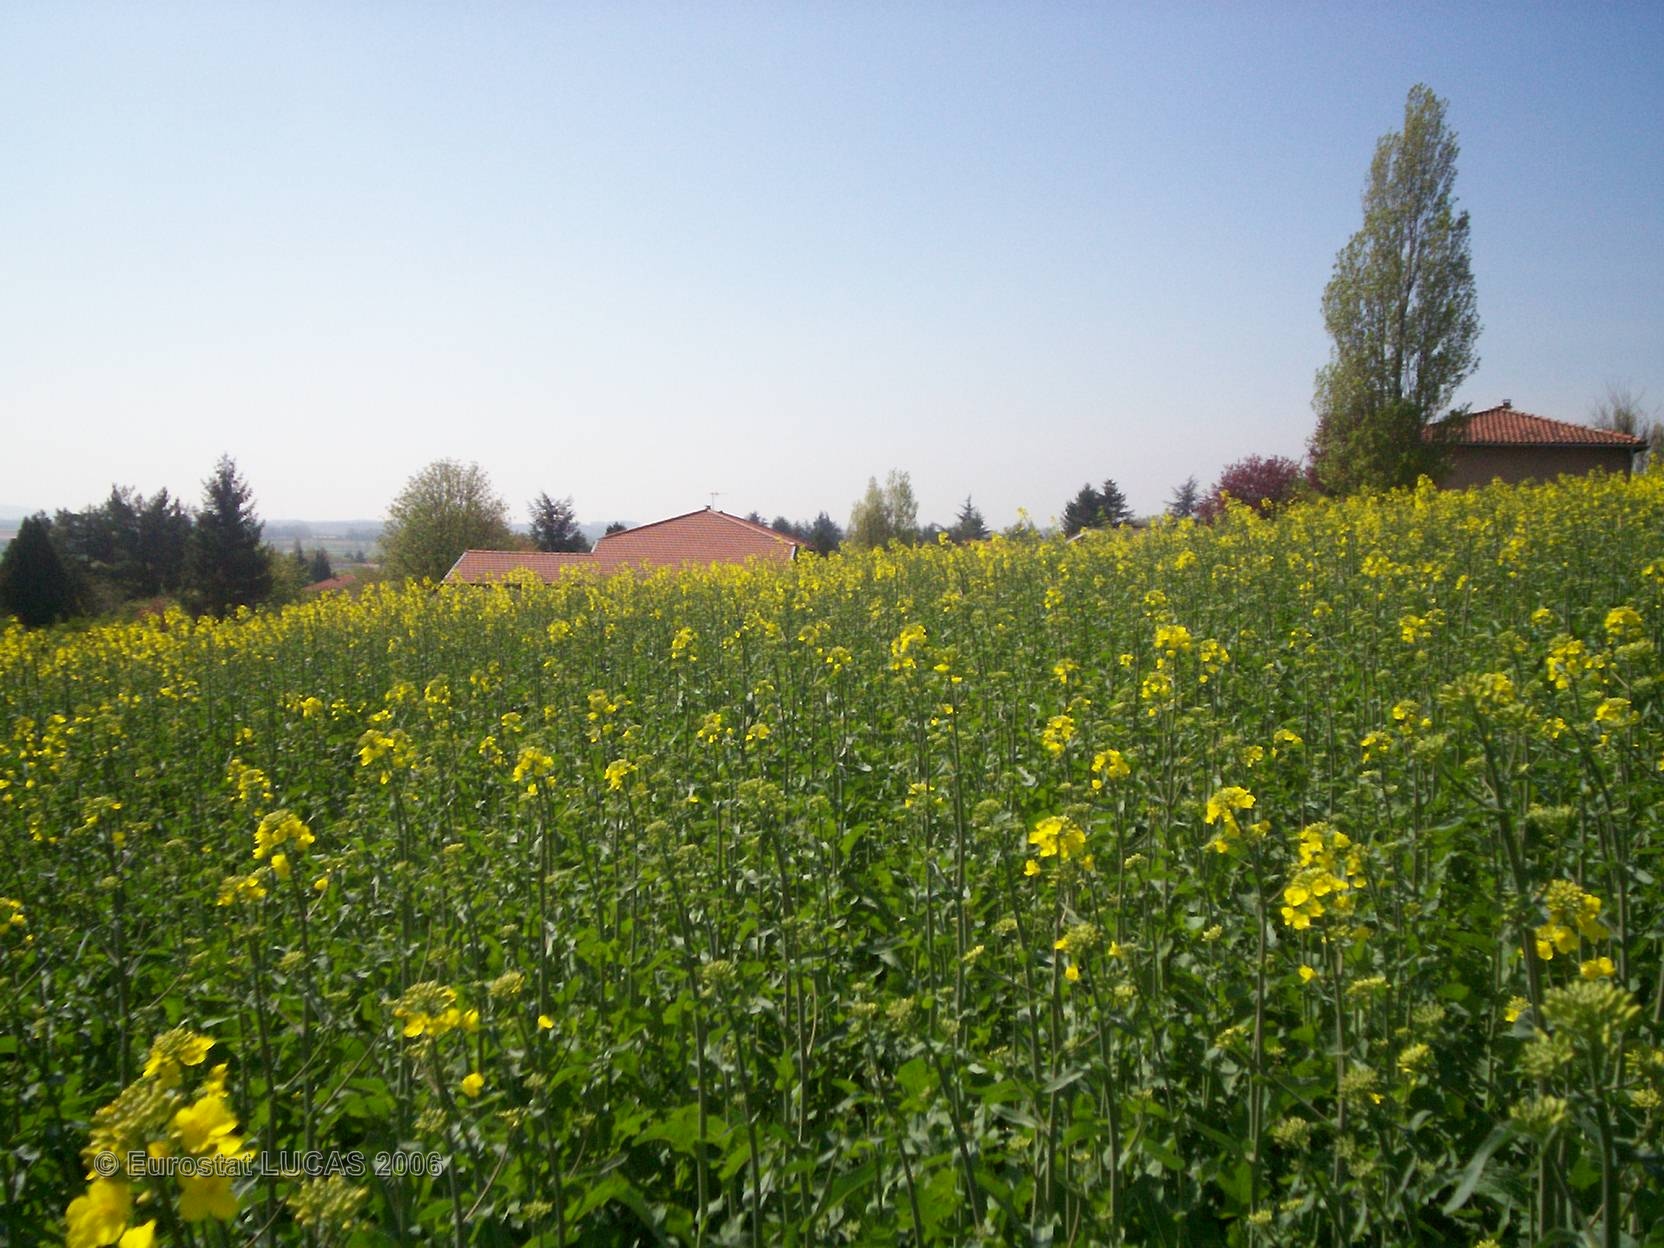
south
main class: Cropland
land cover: Rape and turnip rape
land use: Agriculture (excluding fallow land and kitchen gardens)
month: April
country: FR
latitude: 45.4678
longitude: 4.8242
